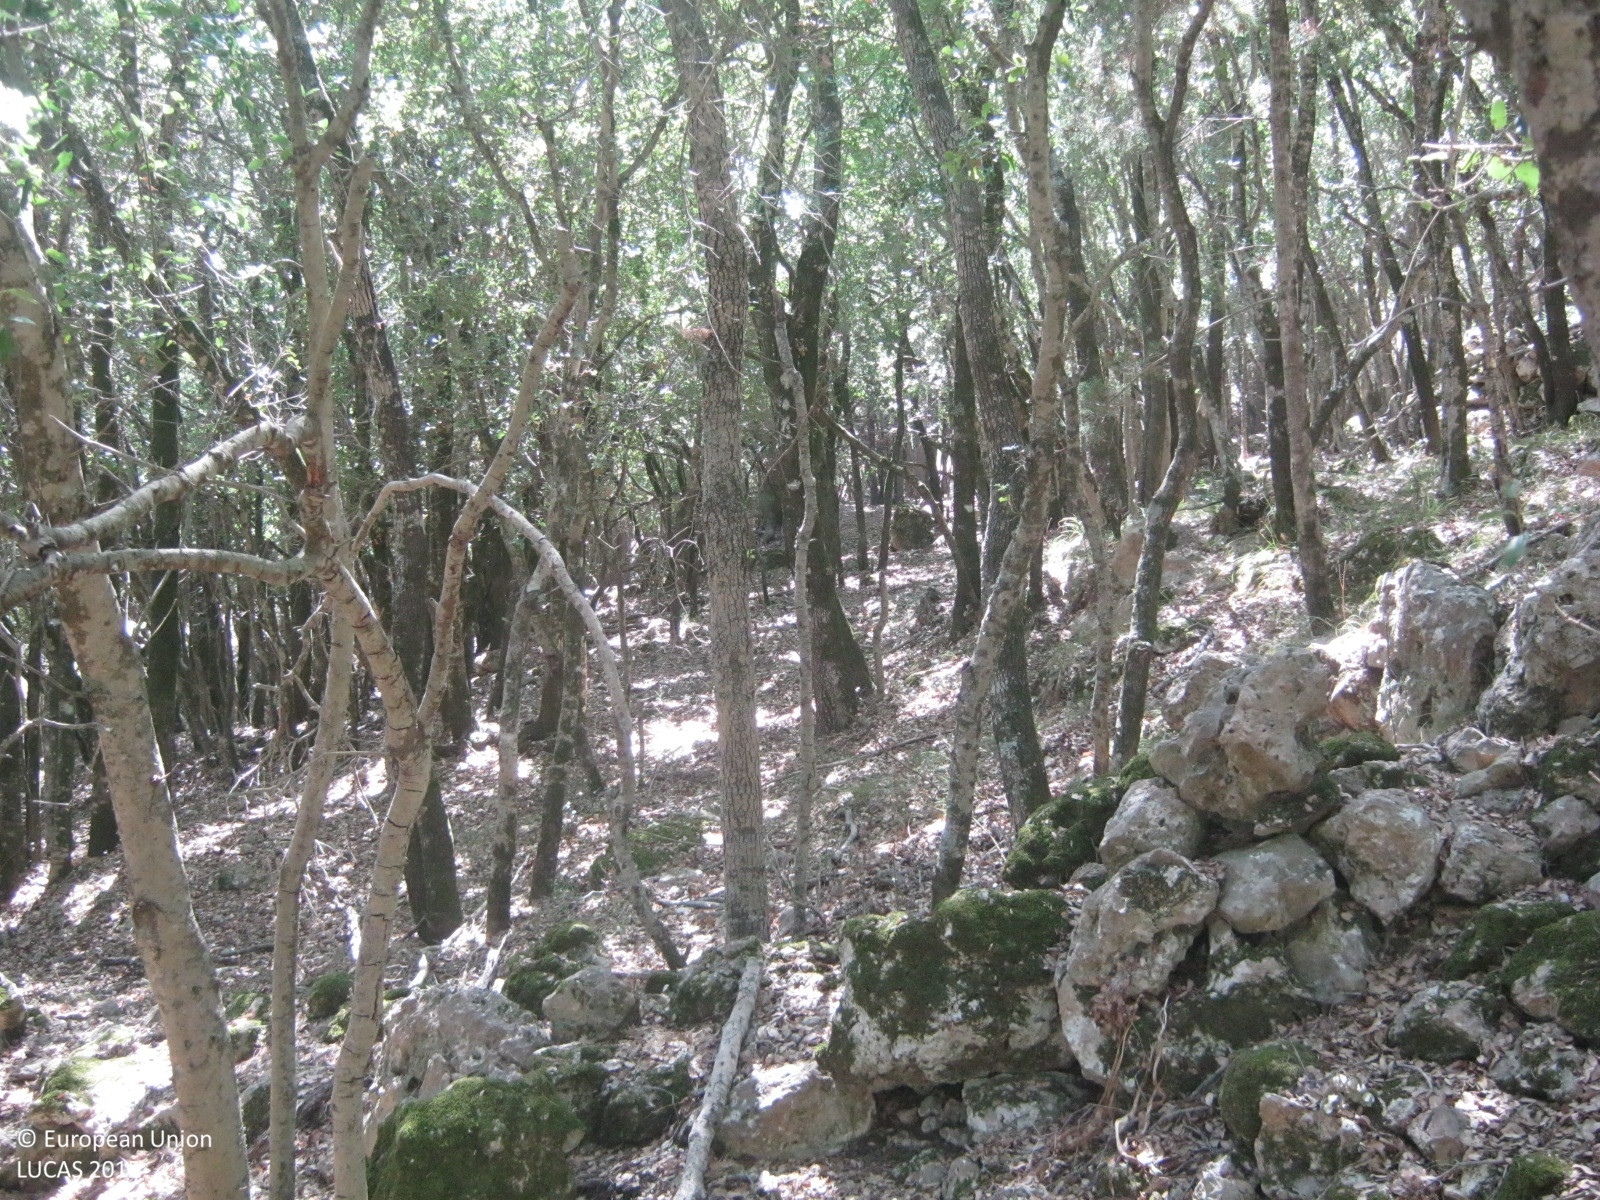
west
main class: Woodland
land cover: Broadleaved woodland
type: thermophilous deciduous forest
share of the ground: > 75 %
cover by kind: broadleaved forest trees 90 %, shrubs 5 %, consolidated bare surface 5 %
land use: Semi-natural and natural areas not in use
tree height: > 5 m
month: July
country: GR
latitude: 38.4187
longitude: 20.5581
